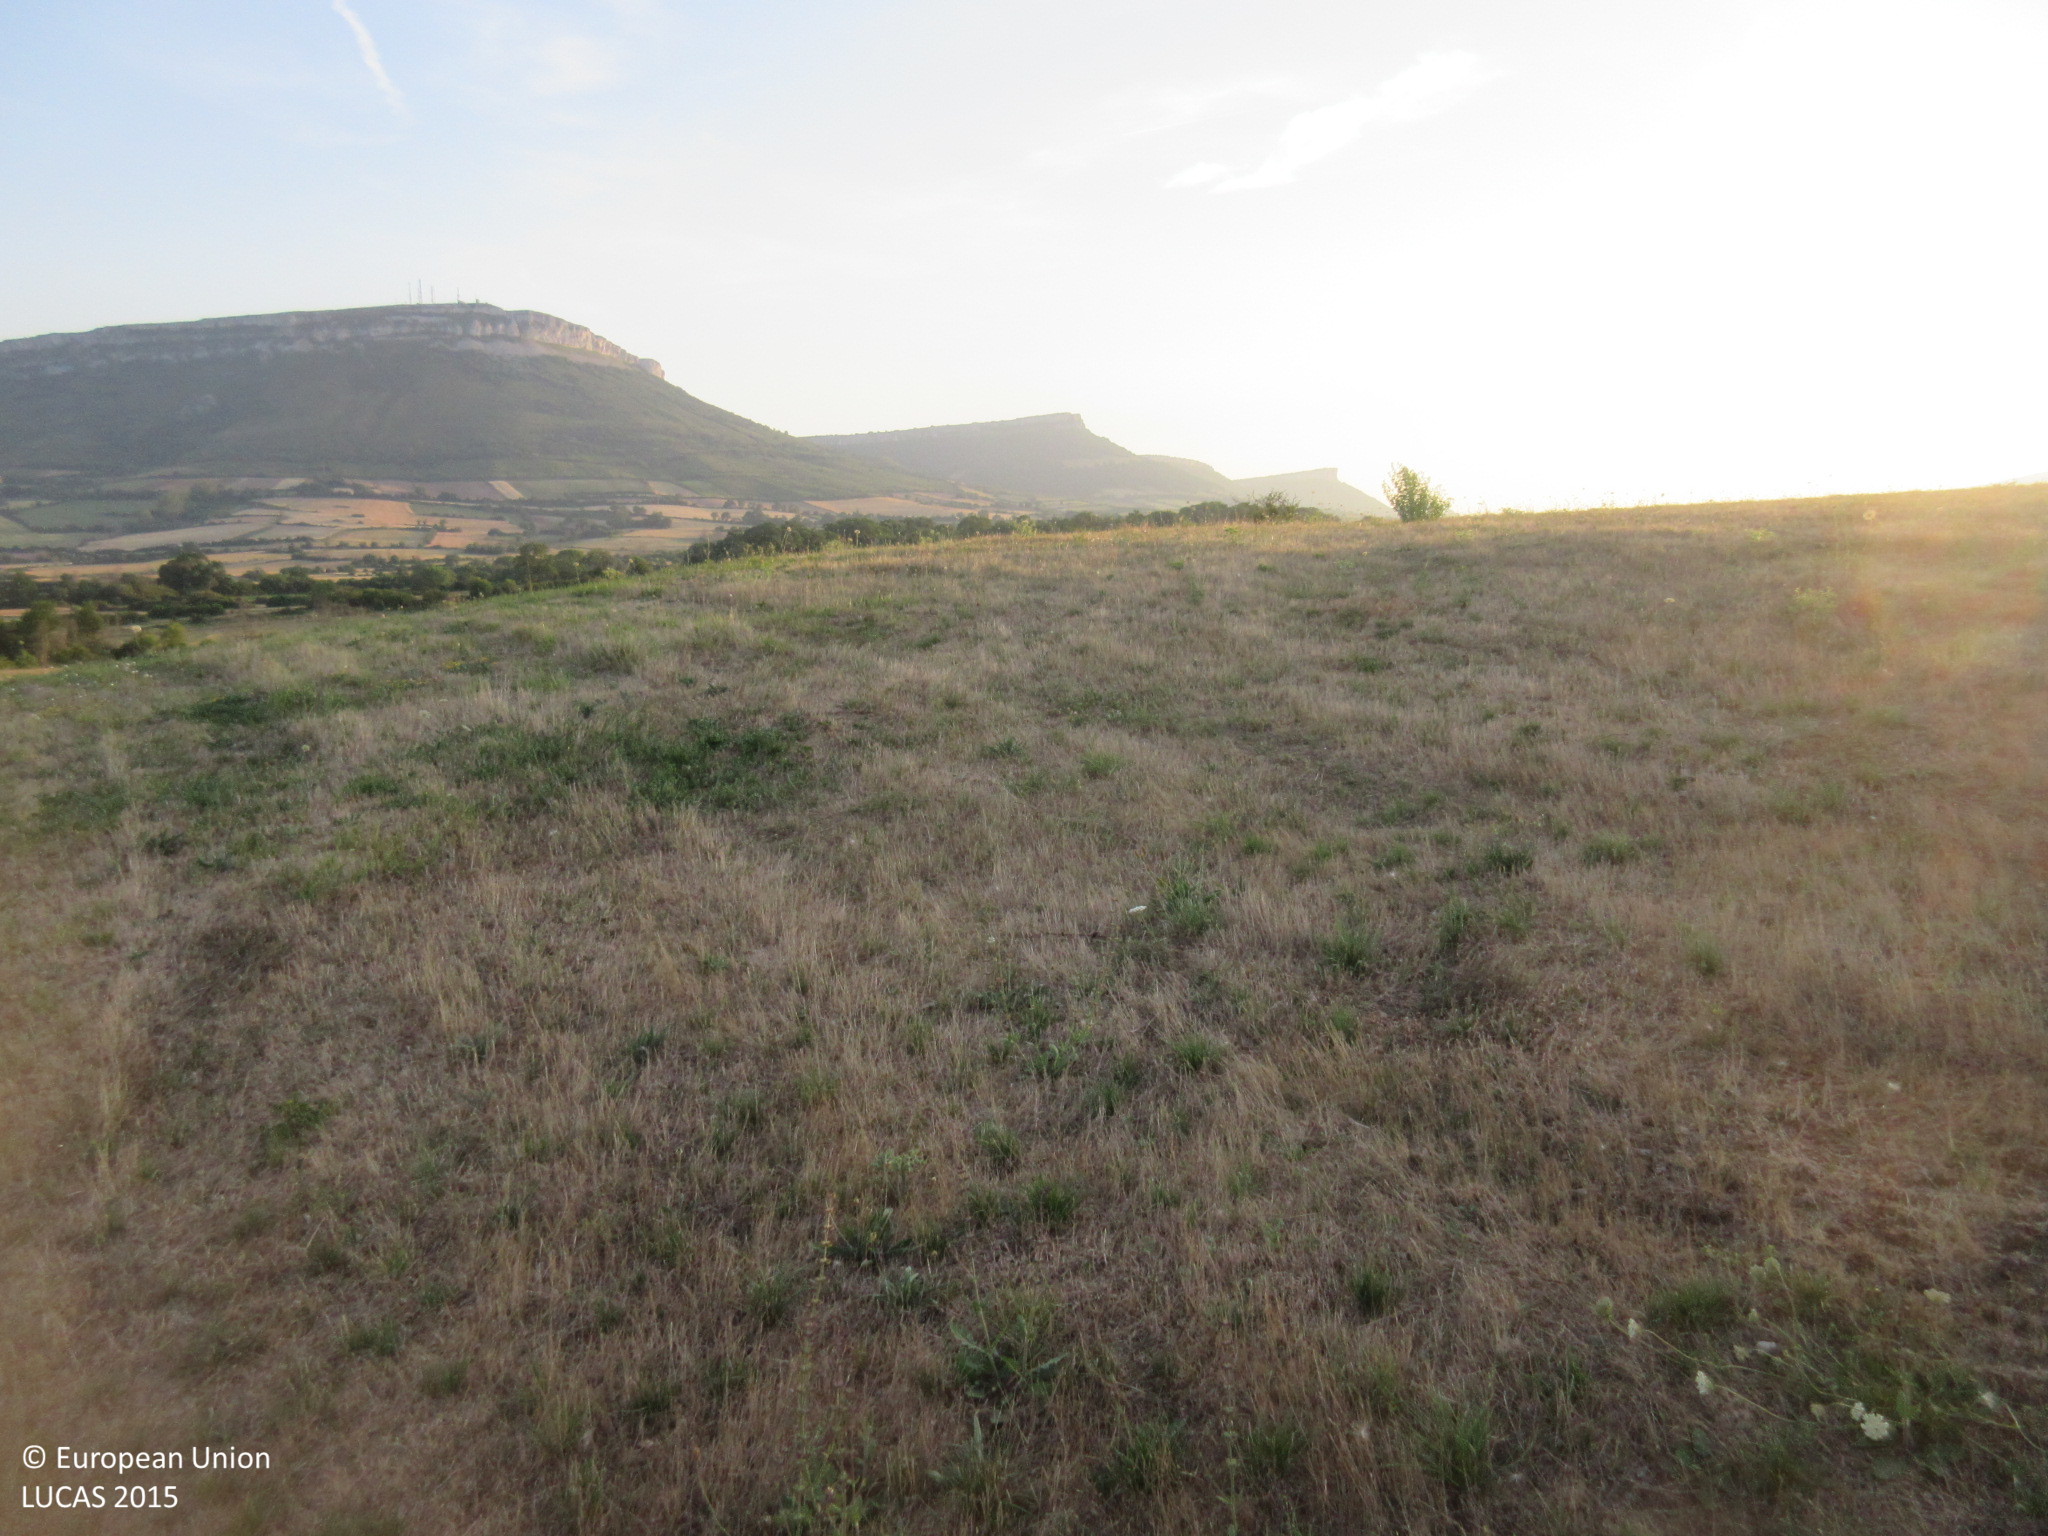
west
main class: Grassland
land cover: Grassland without tree/shrub cover
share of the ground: > 75 %
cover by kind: herbaceous plants 100 %
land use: Agriculture (excluding fallow land and kitchen gardens)
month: July
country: ES
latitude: 43.0604
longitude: -3.5104
